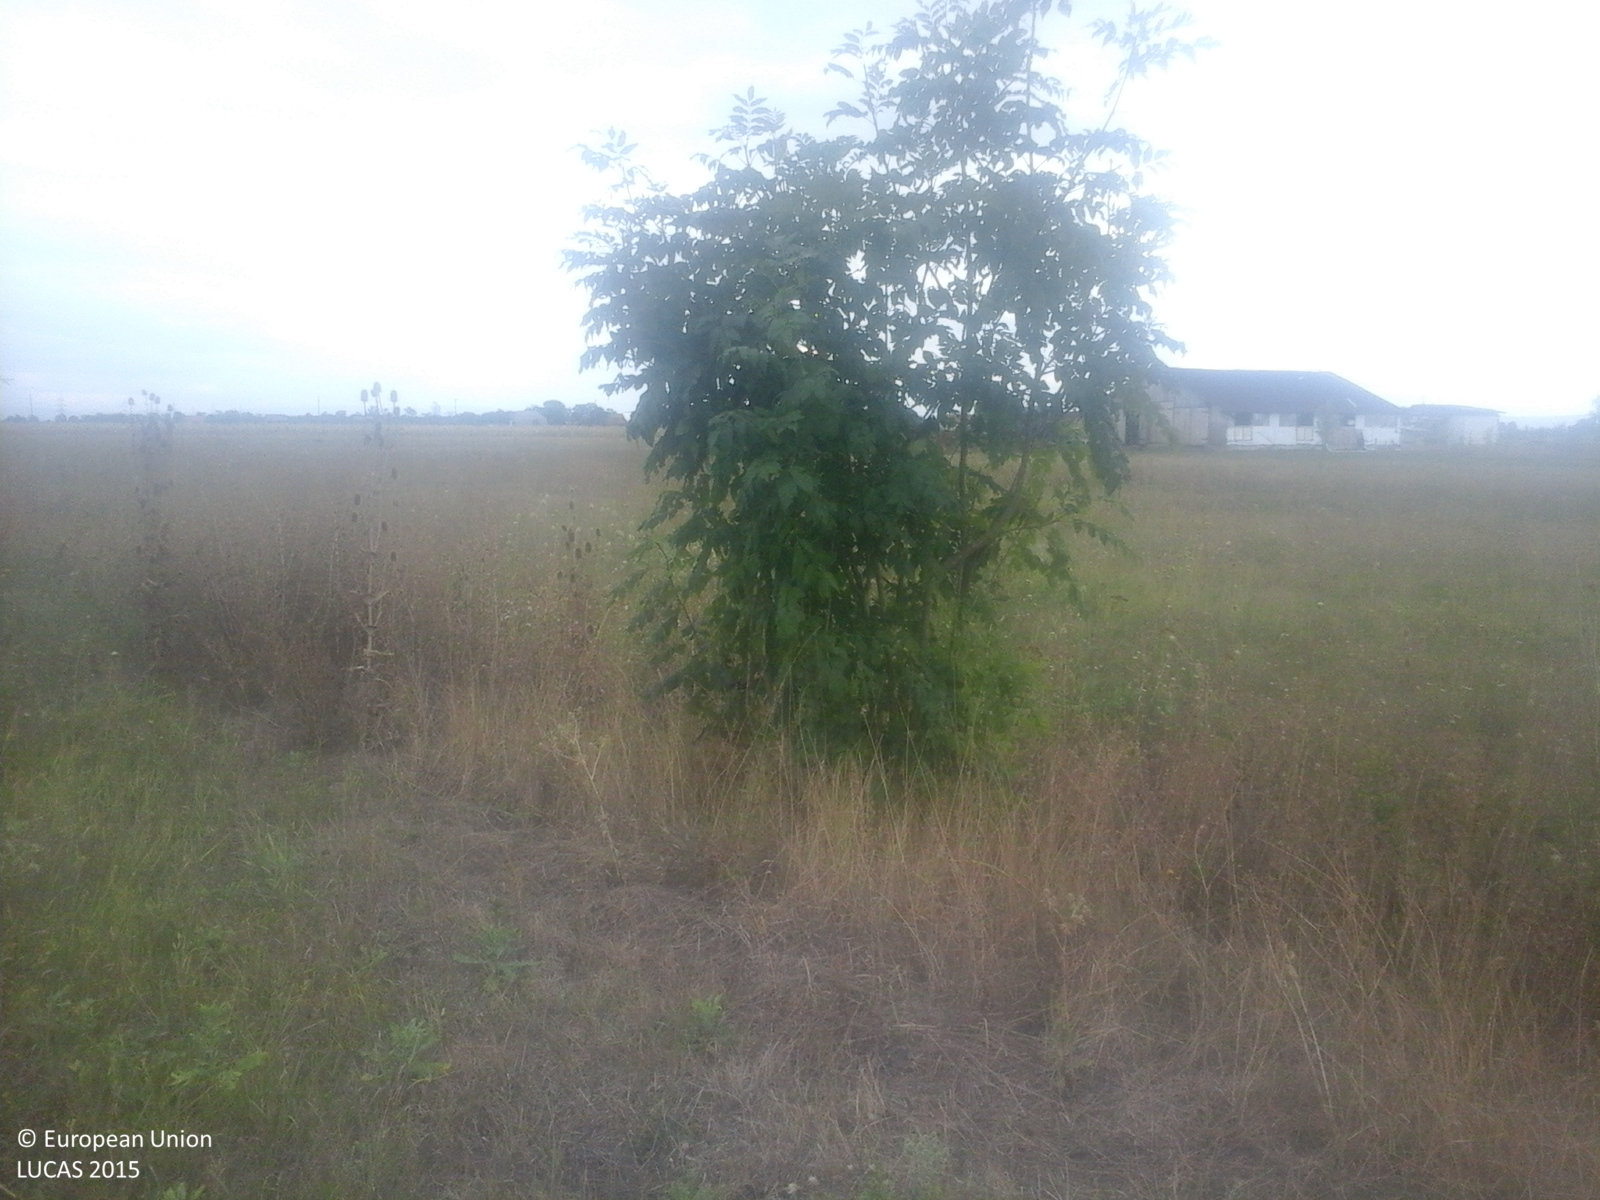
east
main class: Grassland
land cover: Grassland without tree/shrub cover
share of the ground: > 75 %
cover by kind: herbaceous plants 100 %
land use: Agriculture (excluding fallow land and kitchen gardens)
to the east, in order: Grassland without tree/shrub cover; Ditches and canals; Lines of trees; Grassland without tree/shrub cover; Ditches and canals; Fences; Grassland without tree/shrub cover; Maize; Common wheat
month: September
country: RO
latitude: 47.7469
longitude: 22.8006
